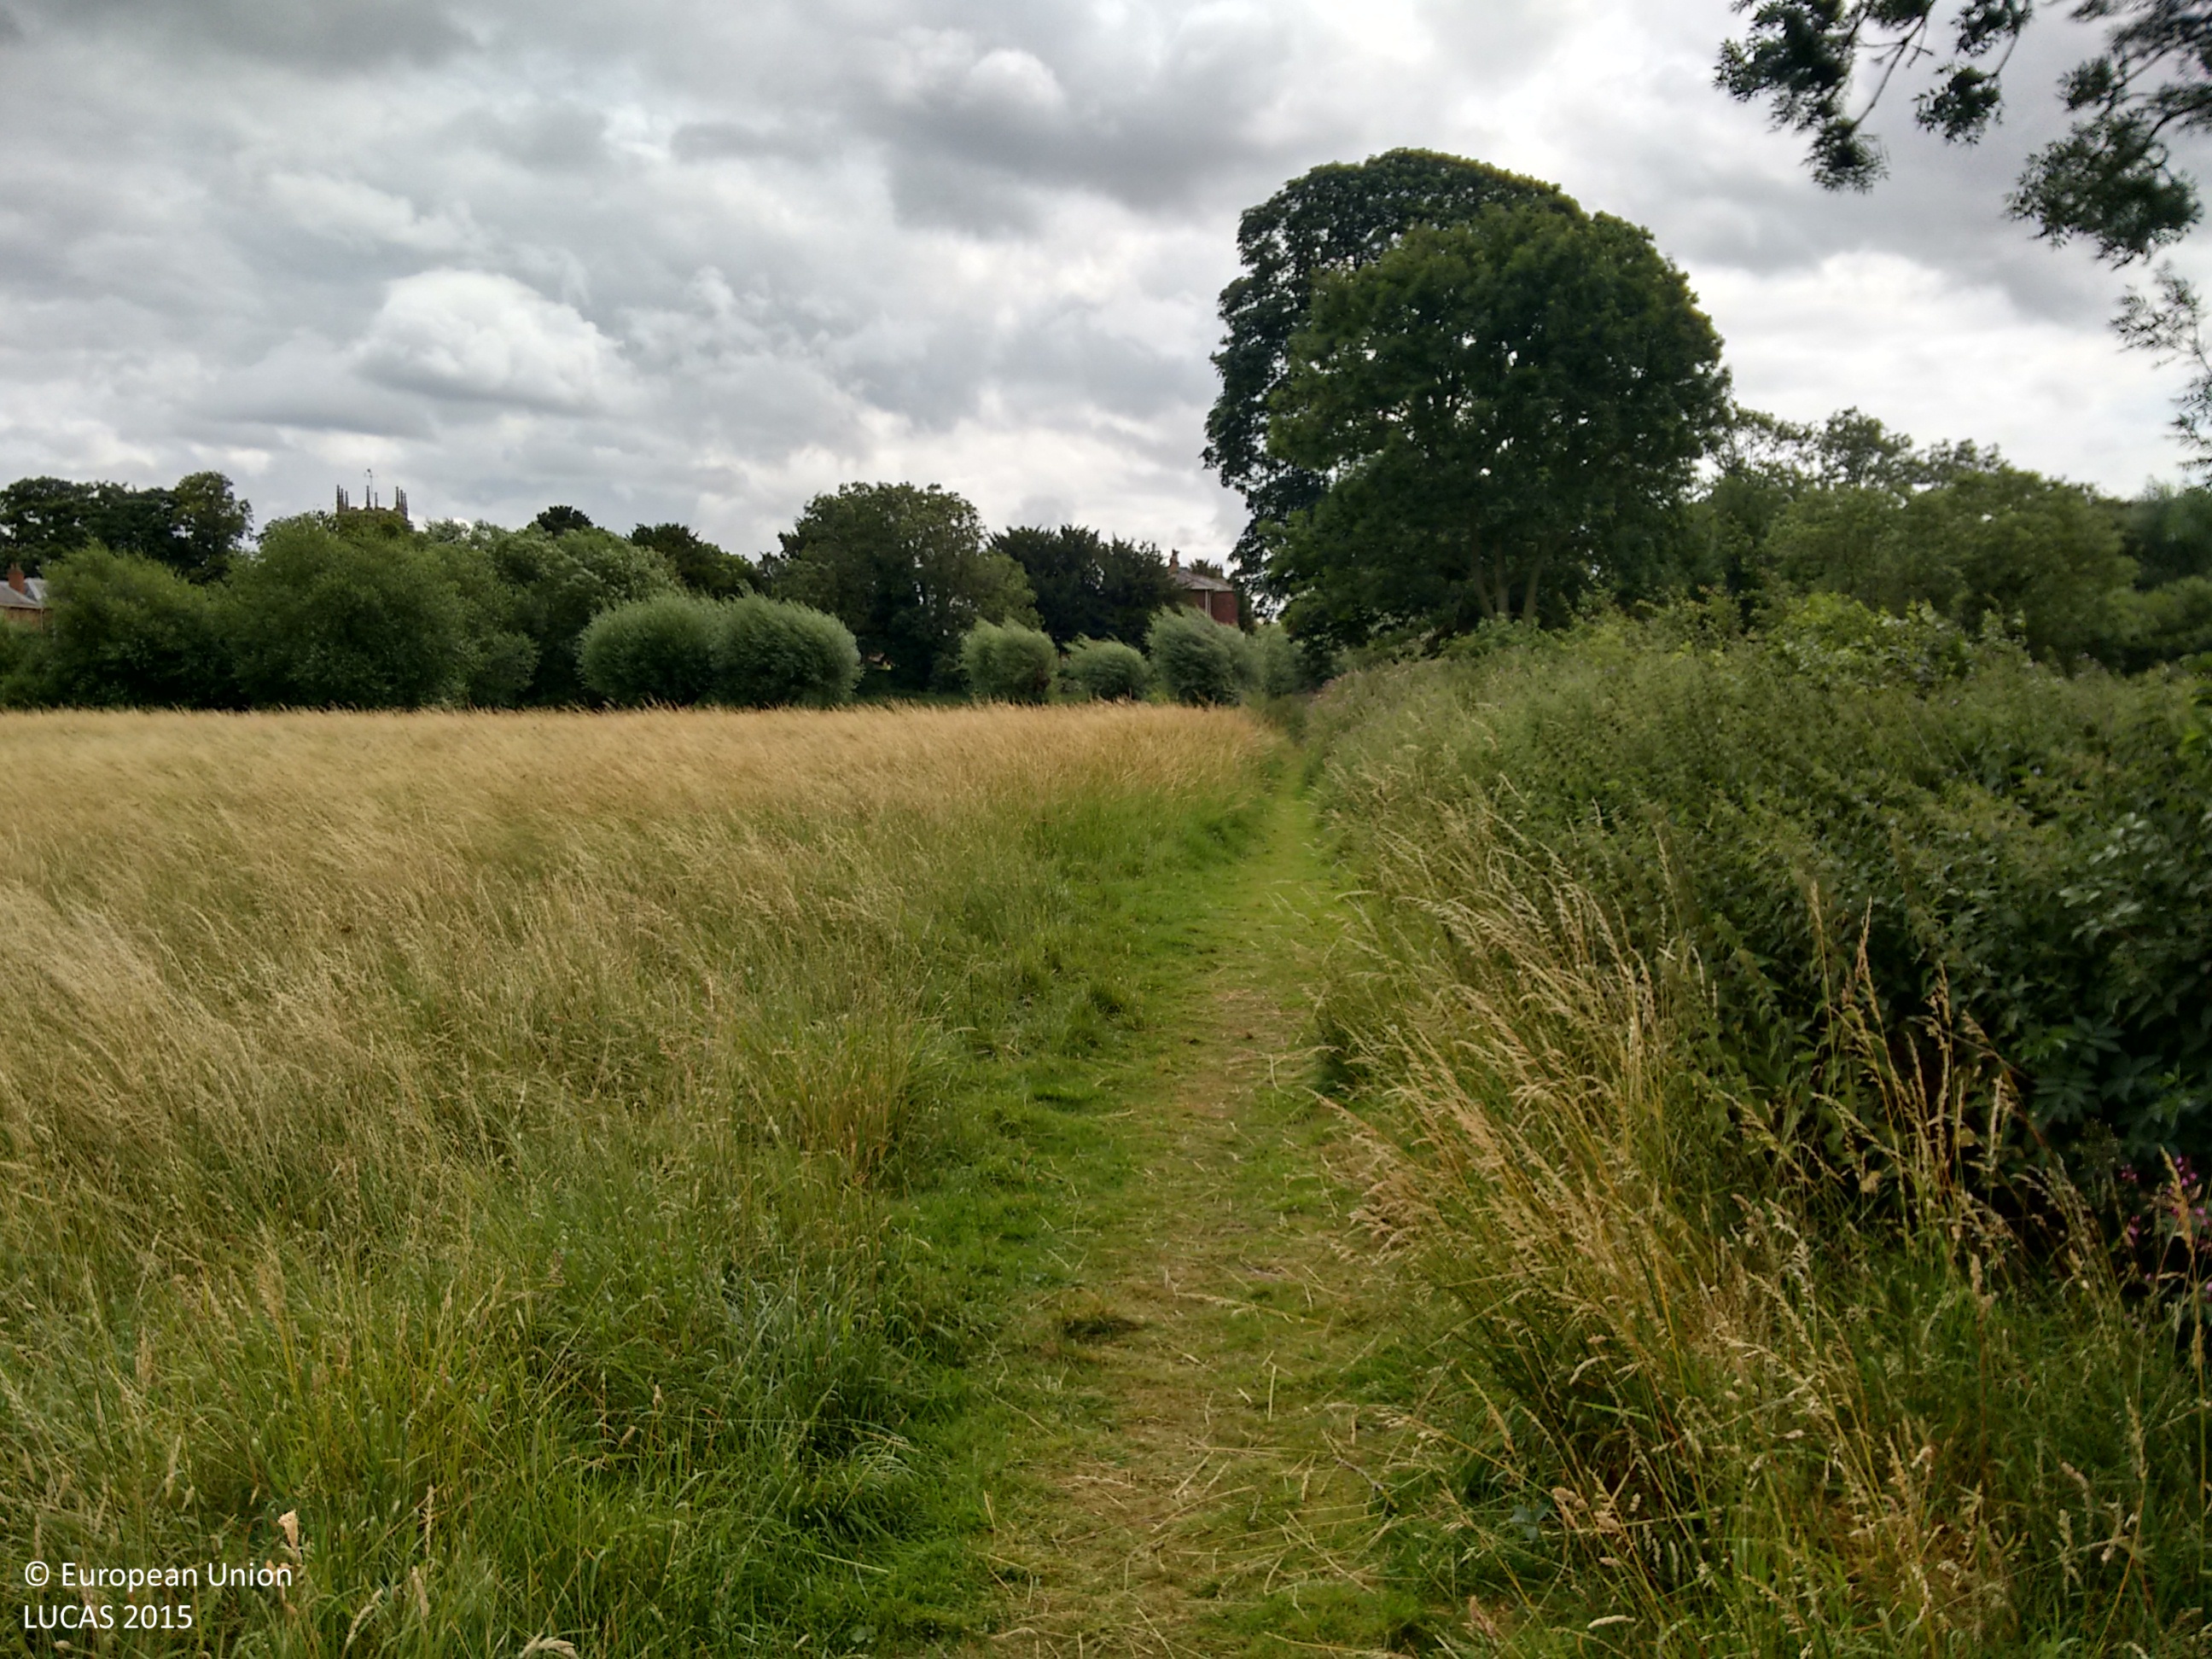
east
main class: Grassland
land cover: Grassland without tree/shrub cover
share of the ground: > 75 %
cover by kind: herbaceous plants 100 %
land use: Agriculture (excluding fallow land and kitchen gardens)
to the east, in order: Grassland without tree/shrub cover; Broadleaved woodland; Inland marshes; Broadleaved woodland; Abandoned hedges; Paved roads, cycling and walking lanes; Artificial constructions in urban areas
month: July
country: GB
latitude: 53.0572
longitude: -0.8593
